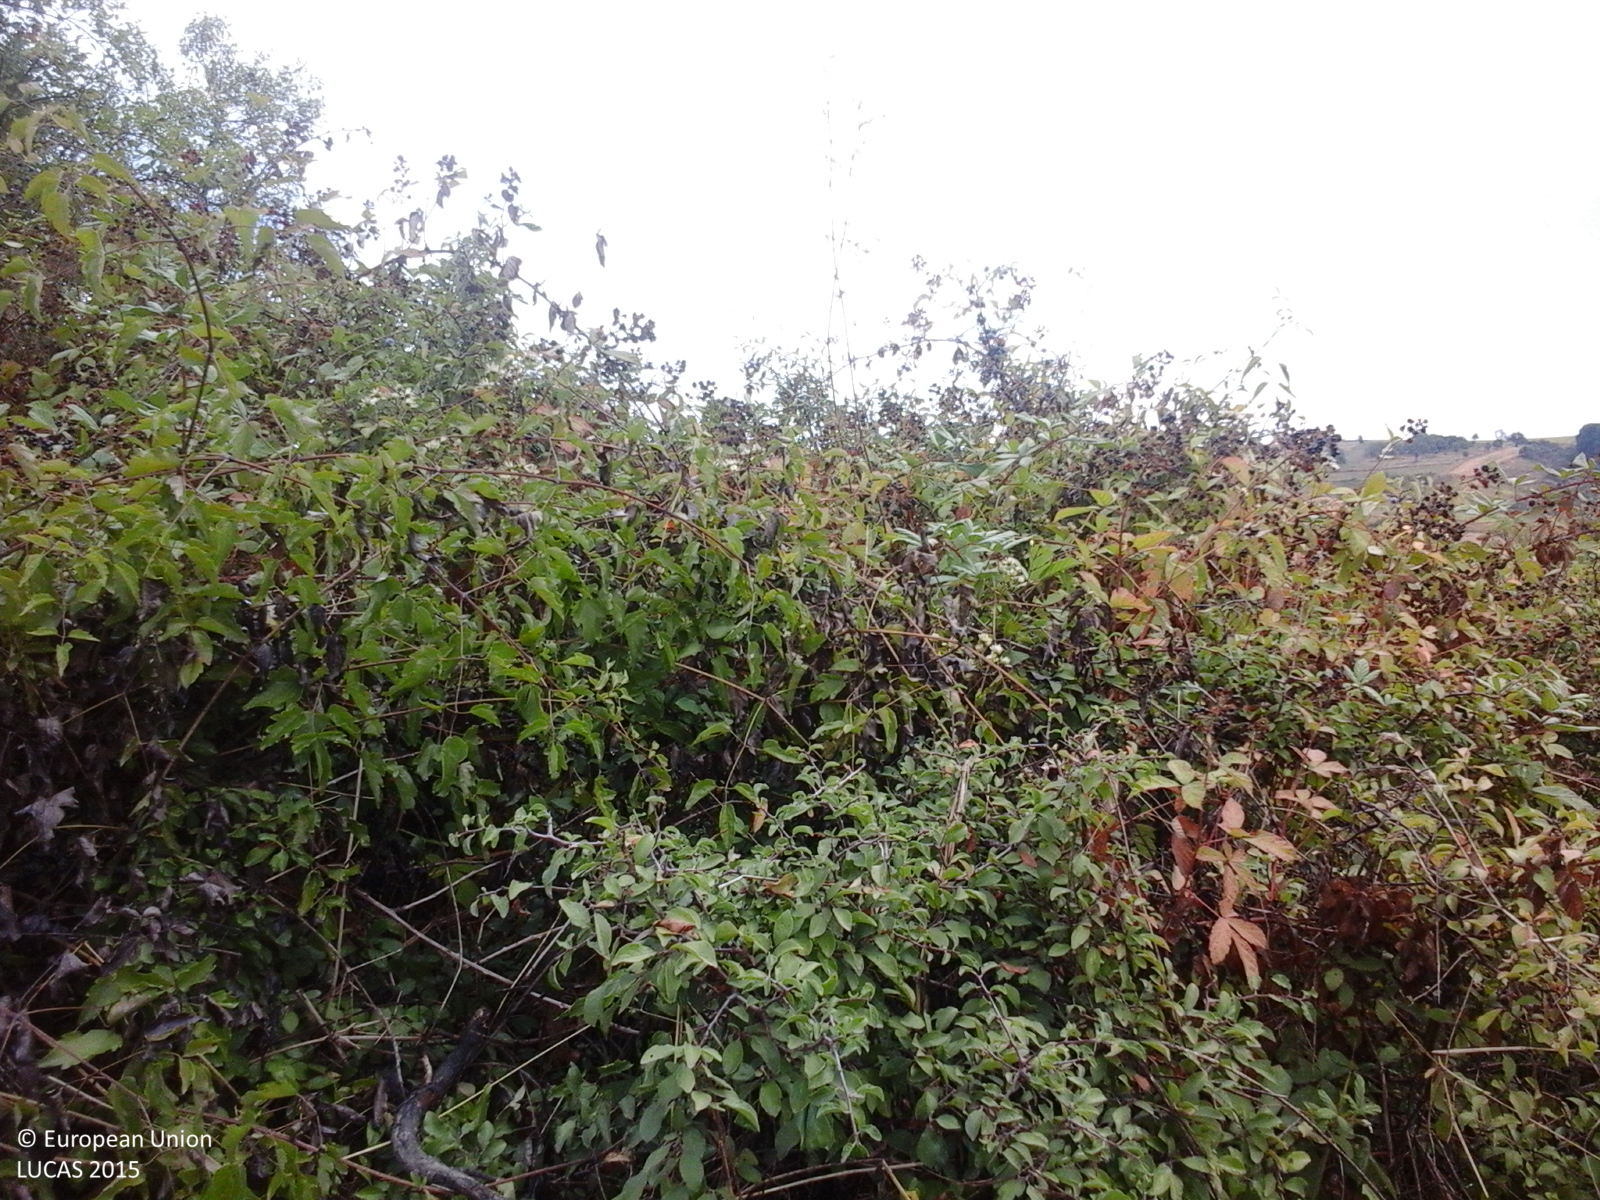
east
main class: Grassland
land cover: Grassland without tree/shrub cover
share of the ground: > 75 %
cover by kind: herbaceous plants 100 %
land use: Agriculture (excluding fallow land and kitchen gardens)
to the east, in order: Tracks; Shrubland without tree cover; Grassland without tree/shrub cover; Apple fruit; Pear fruit; Grassland without tree/shrub cover; Broadleaved woodland; Ditches and canals; Broadleaved woodland; Tracks; Ditches and canals; Electric lines; Spontaneously vegetated surfaces; Maize
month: August
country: RO
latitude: 44.7061
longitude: 21.8578
